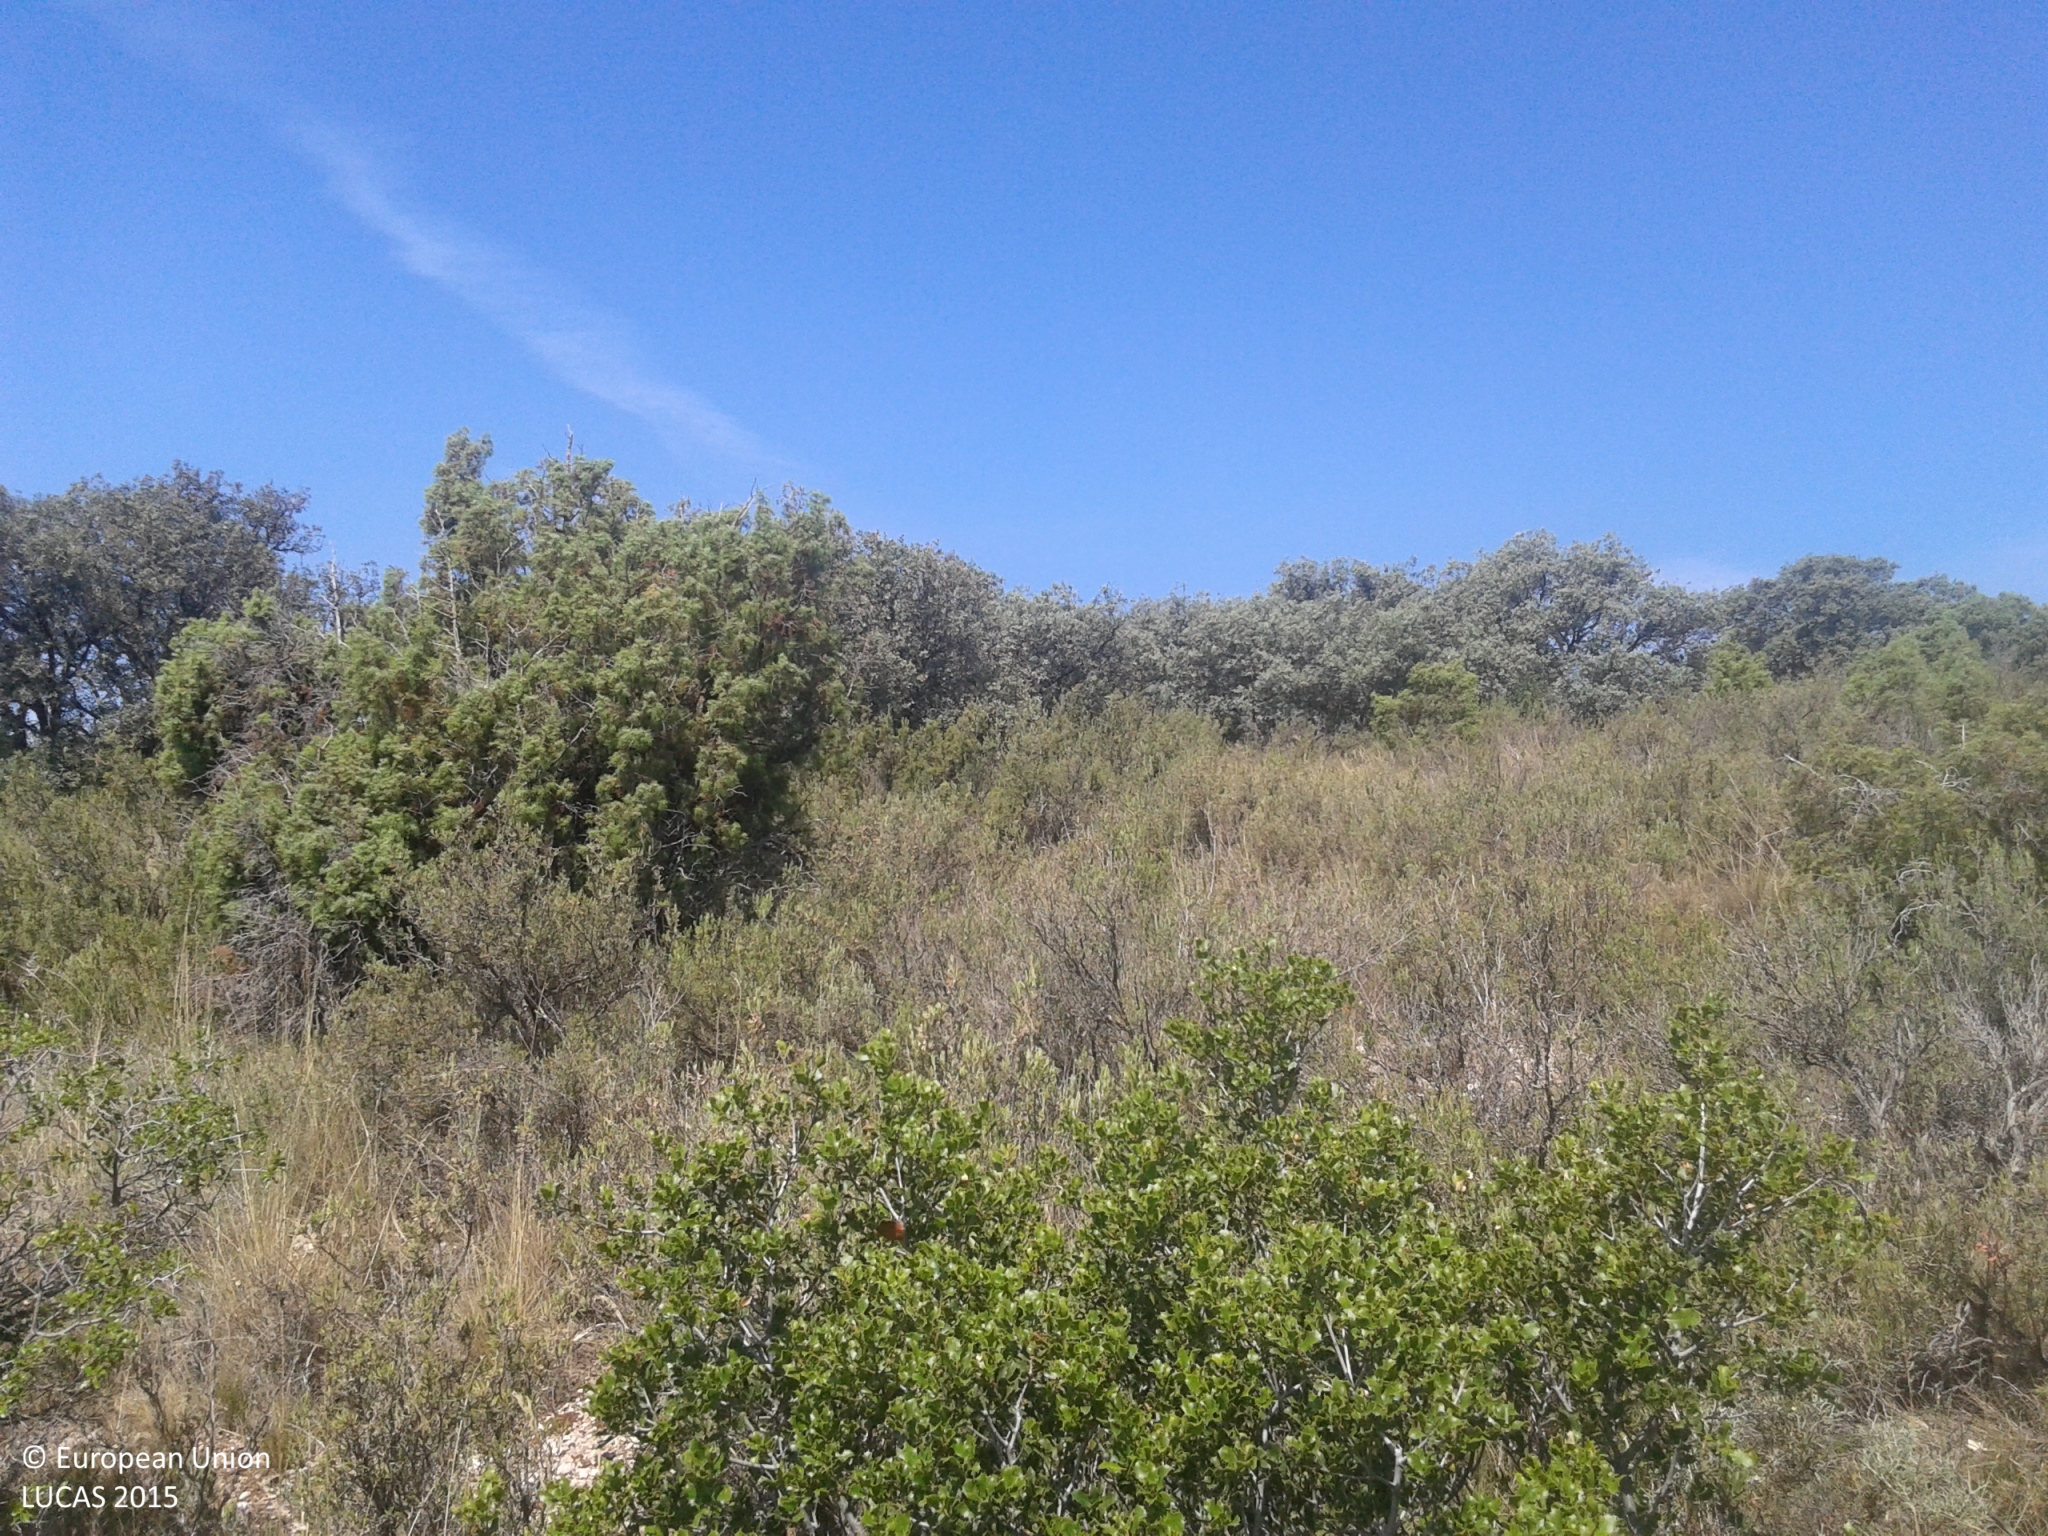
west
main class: Woodland
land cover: Broadleaved woodland
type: broadleaved evergreen forest
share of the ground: 10 - 25 %
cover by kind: shrubs 70 %, broadleaved forest trees 15 %, herbaceous plants 15 %
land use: Semi-natural and natural areas not in use
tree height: > 5 m
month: June
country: ES
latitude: 41.8729
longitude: 0.6237
